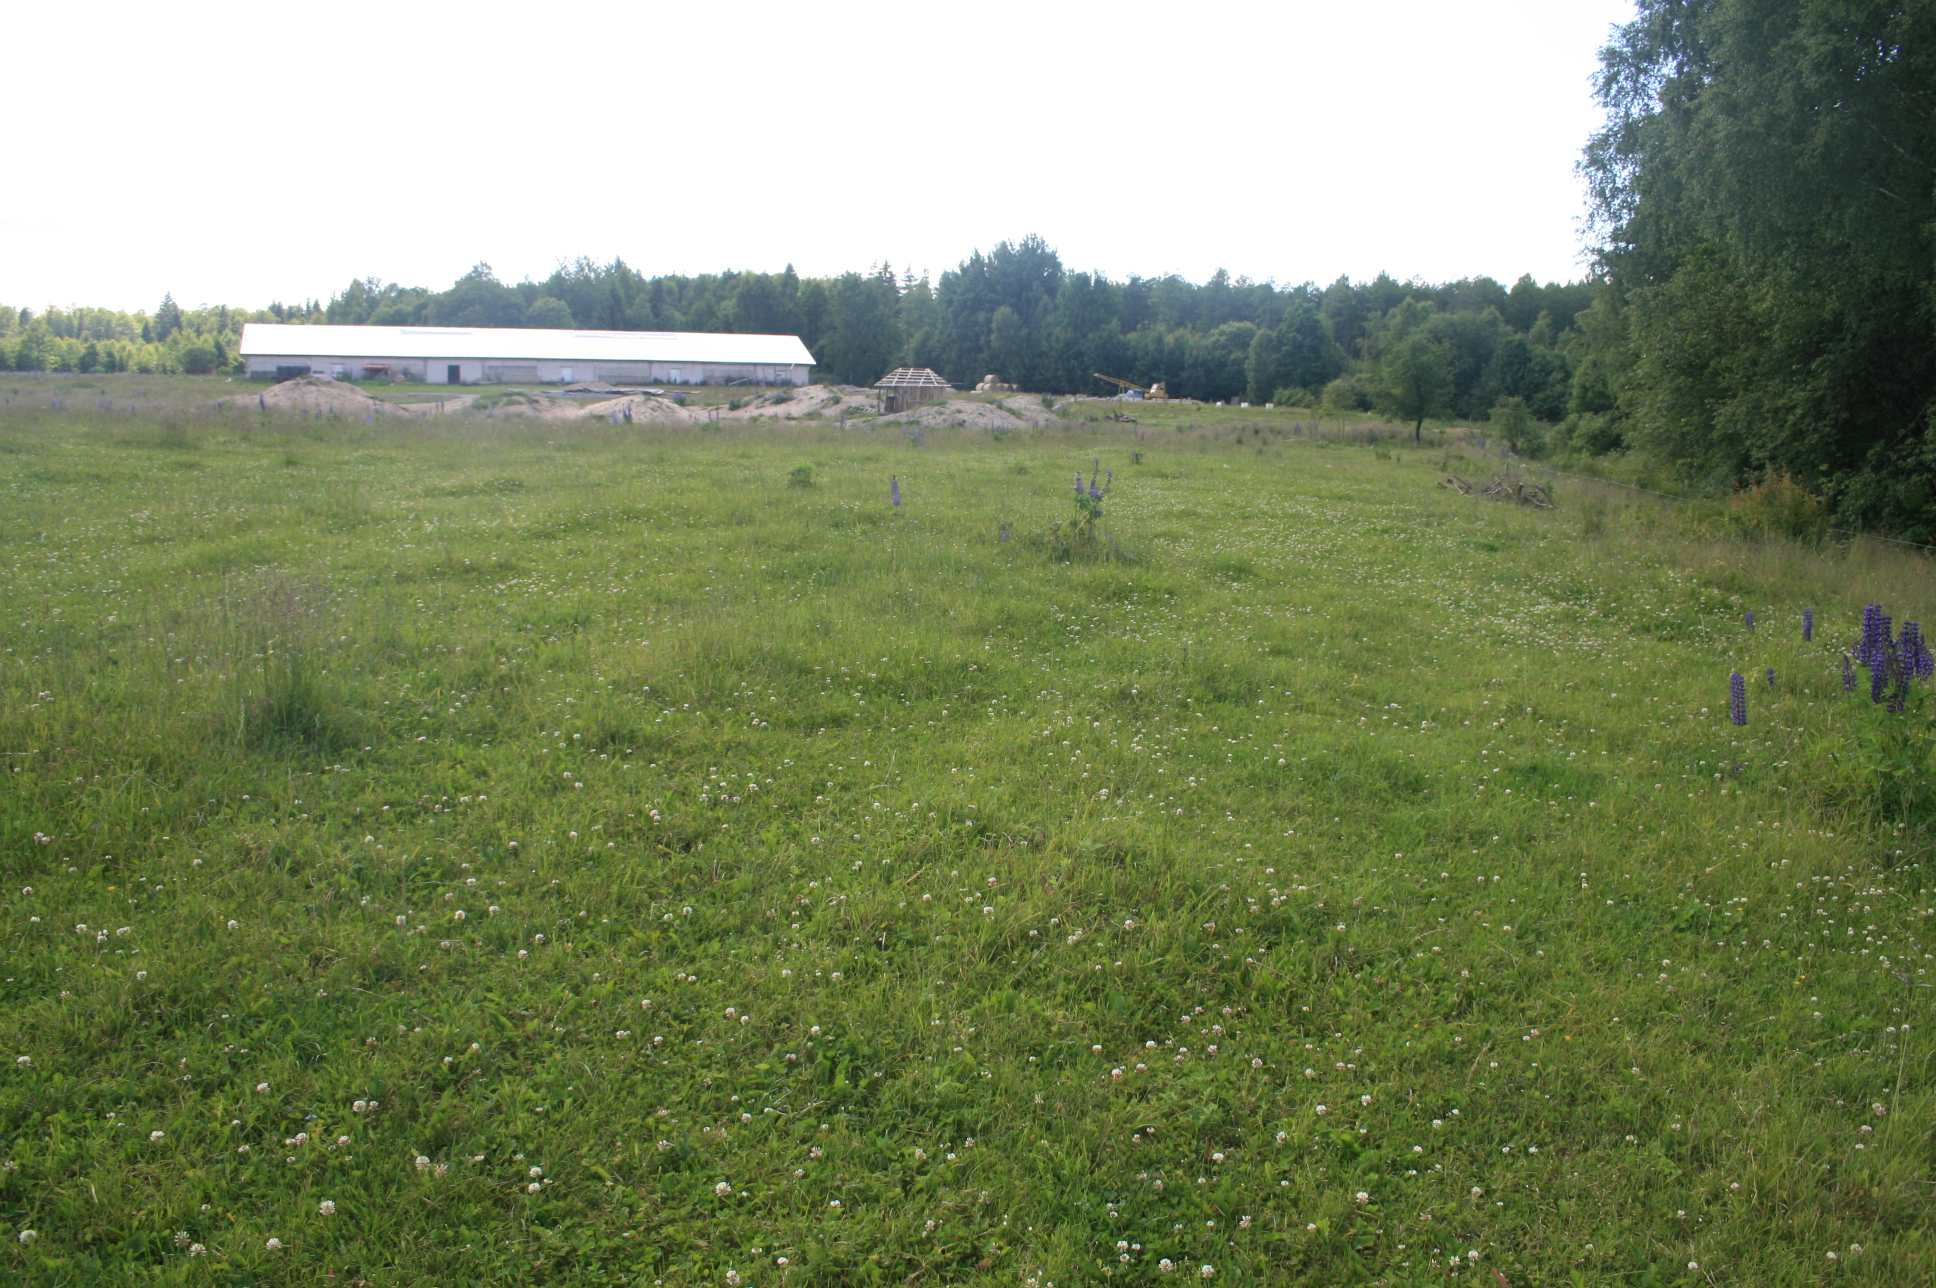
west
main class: Grassland
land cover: Grassland without tree/shrub cover
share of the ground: > 75 %
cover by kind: herbaceous plants 100 %
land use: Agriculture (excluding fallow land and kitchen gardens)
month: June
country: LT
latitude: 55.4234
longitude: 22.1746
